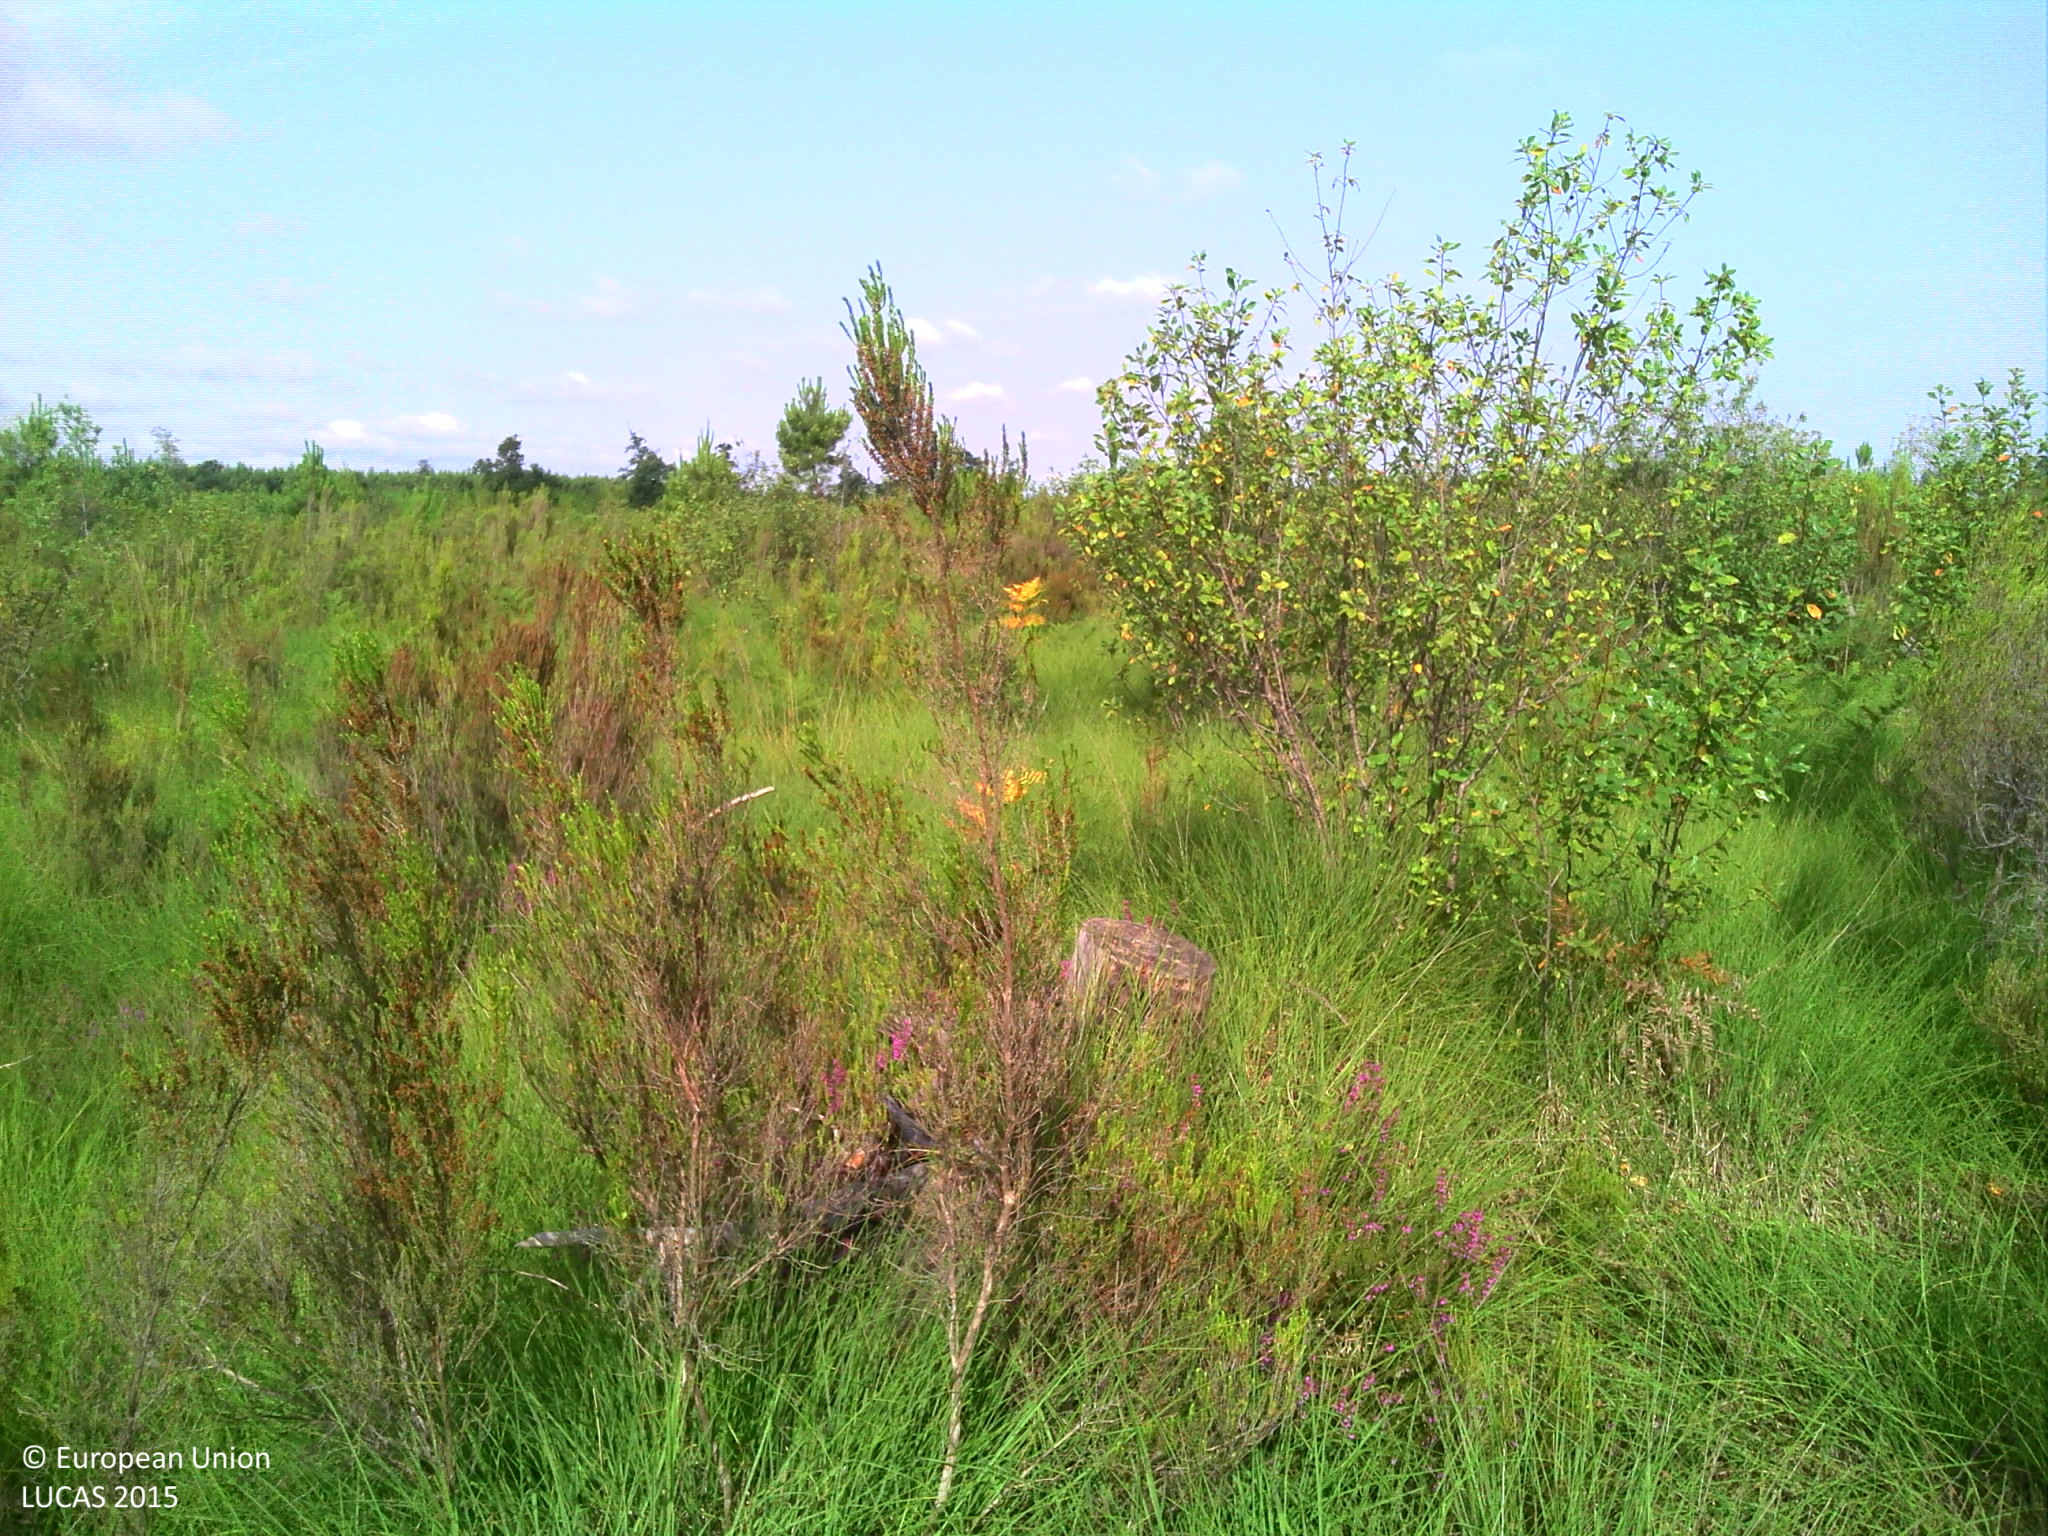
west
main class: Shrubland
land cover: Shrubland with sparse tree cover
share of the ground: > 75 %
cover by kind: shrubs 70 %, herbaceous plants 25 %, coniferous forest trees 5 %
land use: Forestry
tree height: < 5 m
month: July
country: FR
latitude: 44.1129
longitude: -0.6223
